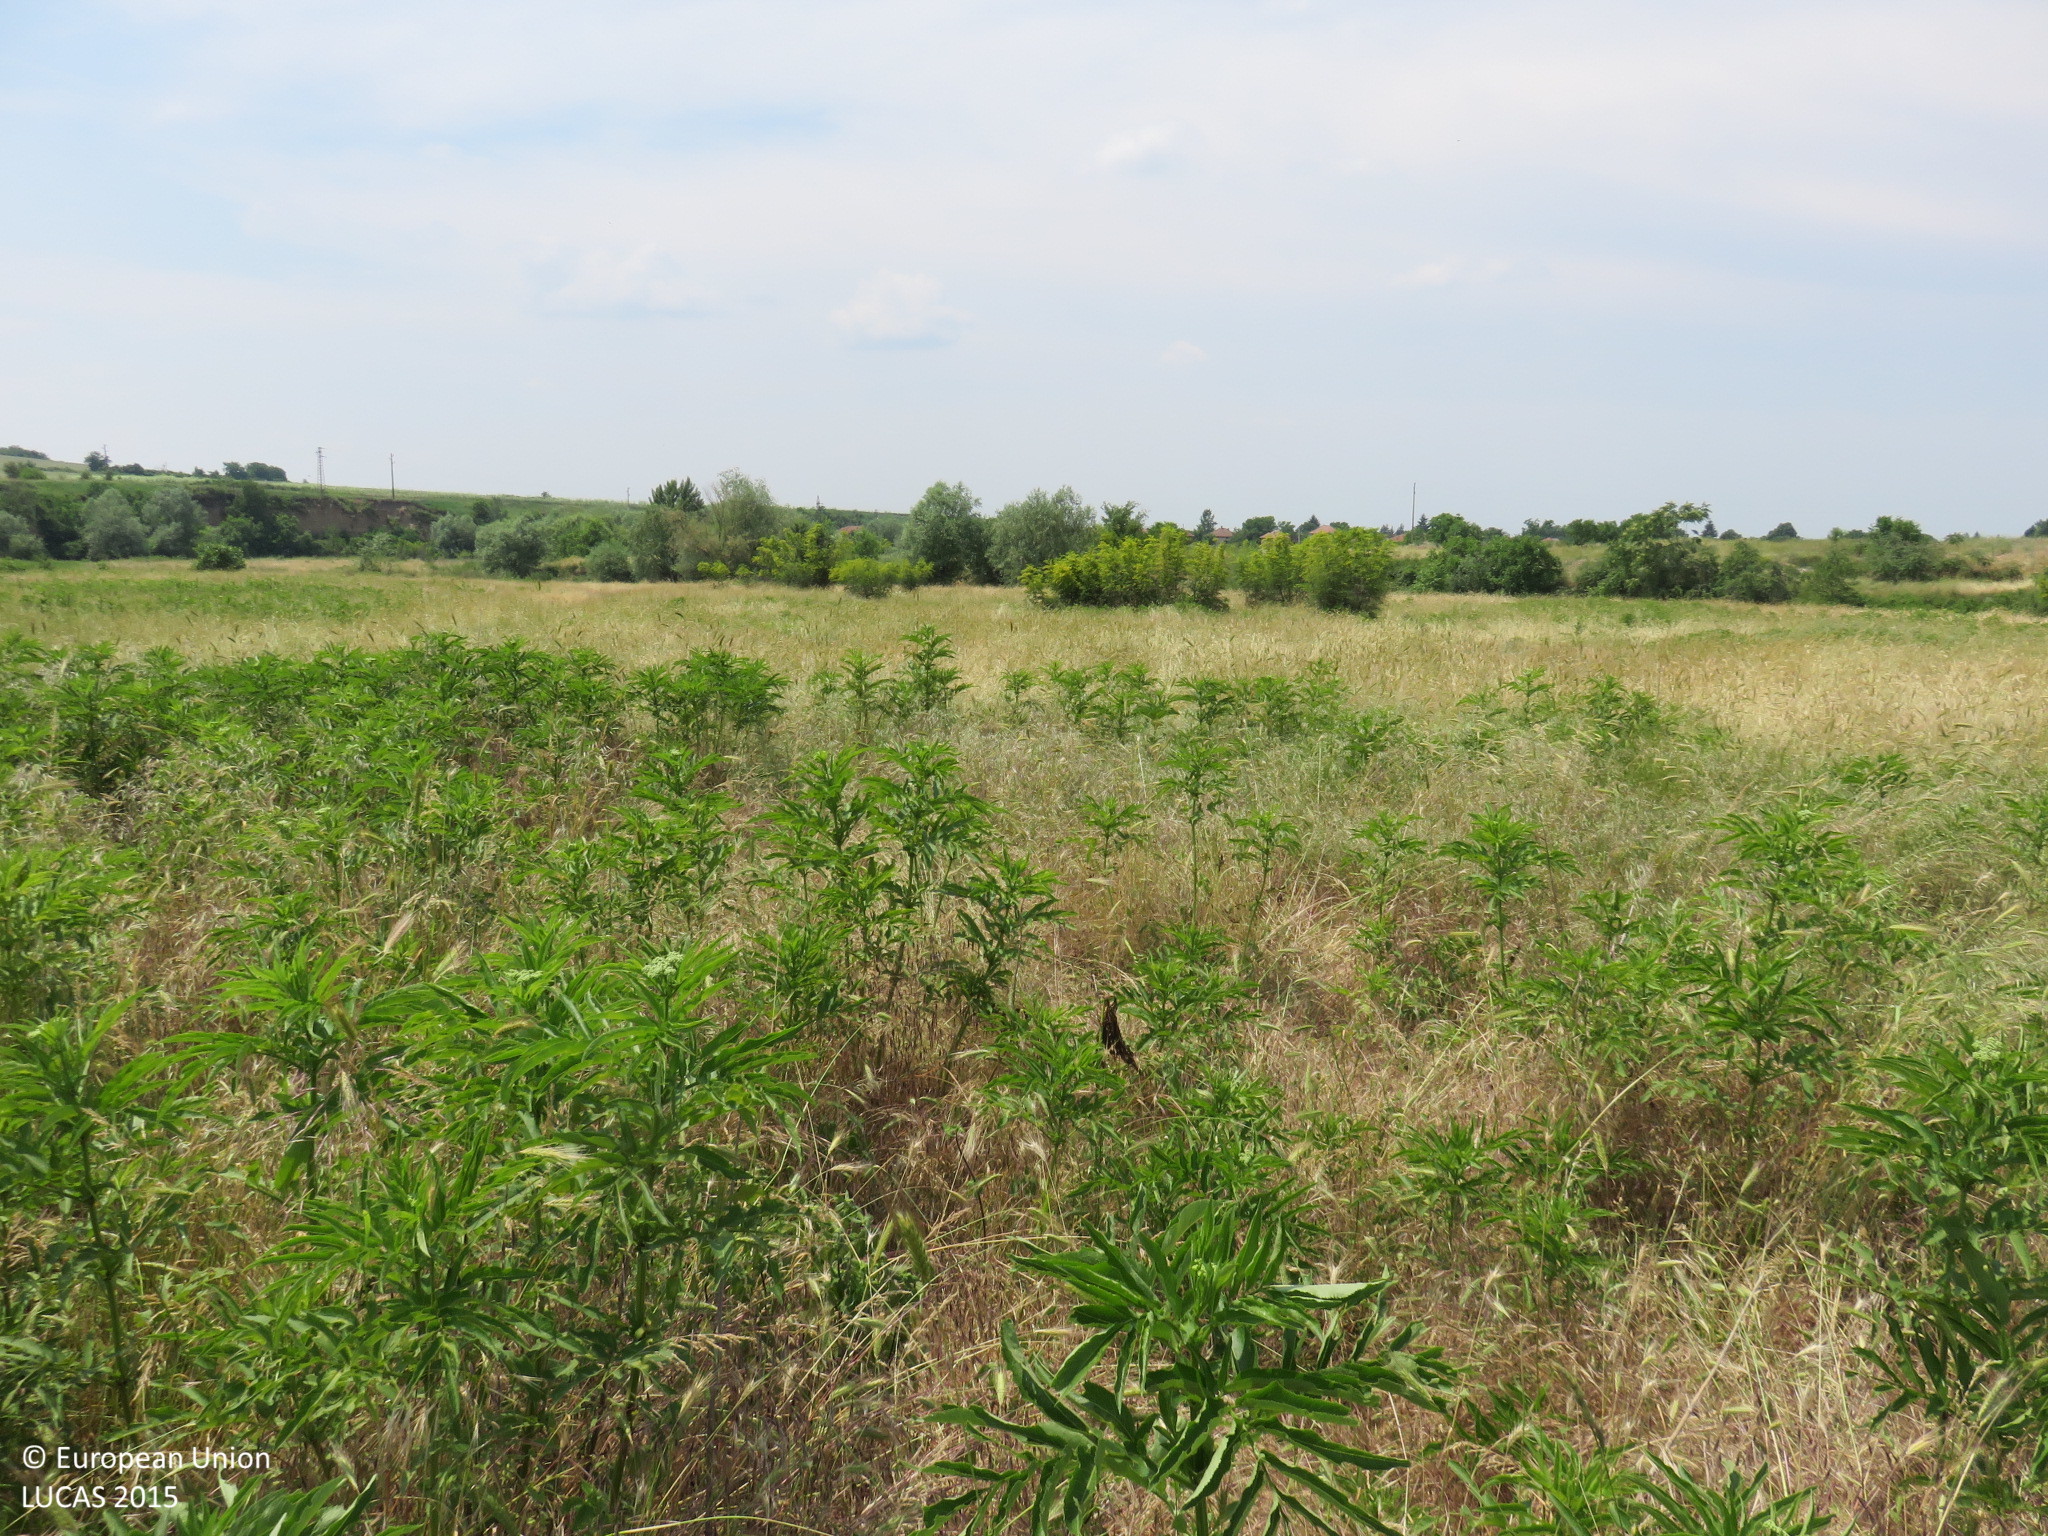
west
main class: Grassland
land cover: Grassland without tree/shrub cover
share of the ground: > 75 %
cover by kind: herbaceous plants 100 %
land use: Agriculture (excluding fallow land and kitchen gardens)
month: June
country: BG
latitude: 43.3787
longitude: 24.5141
